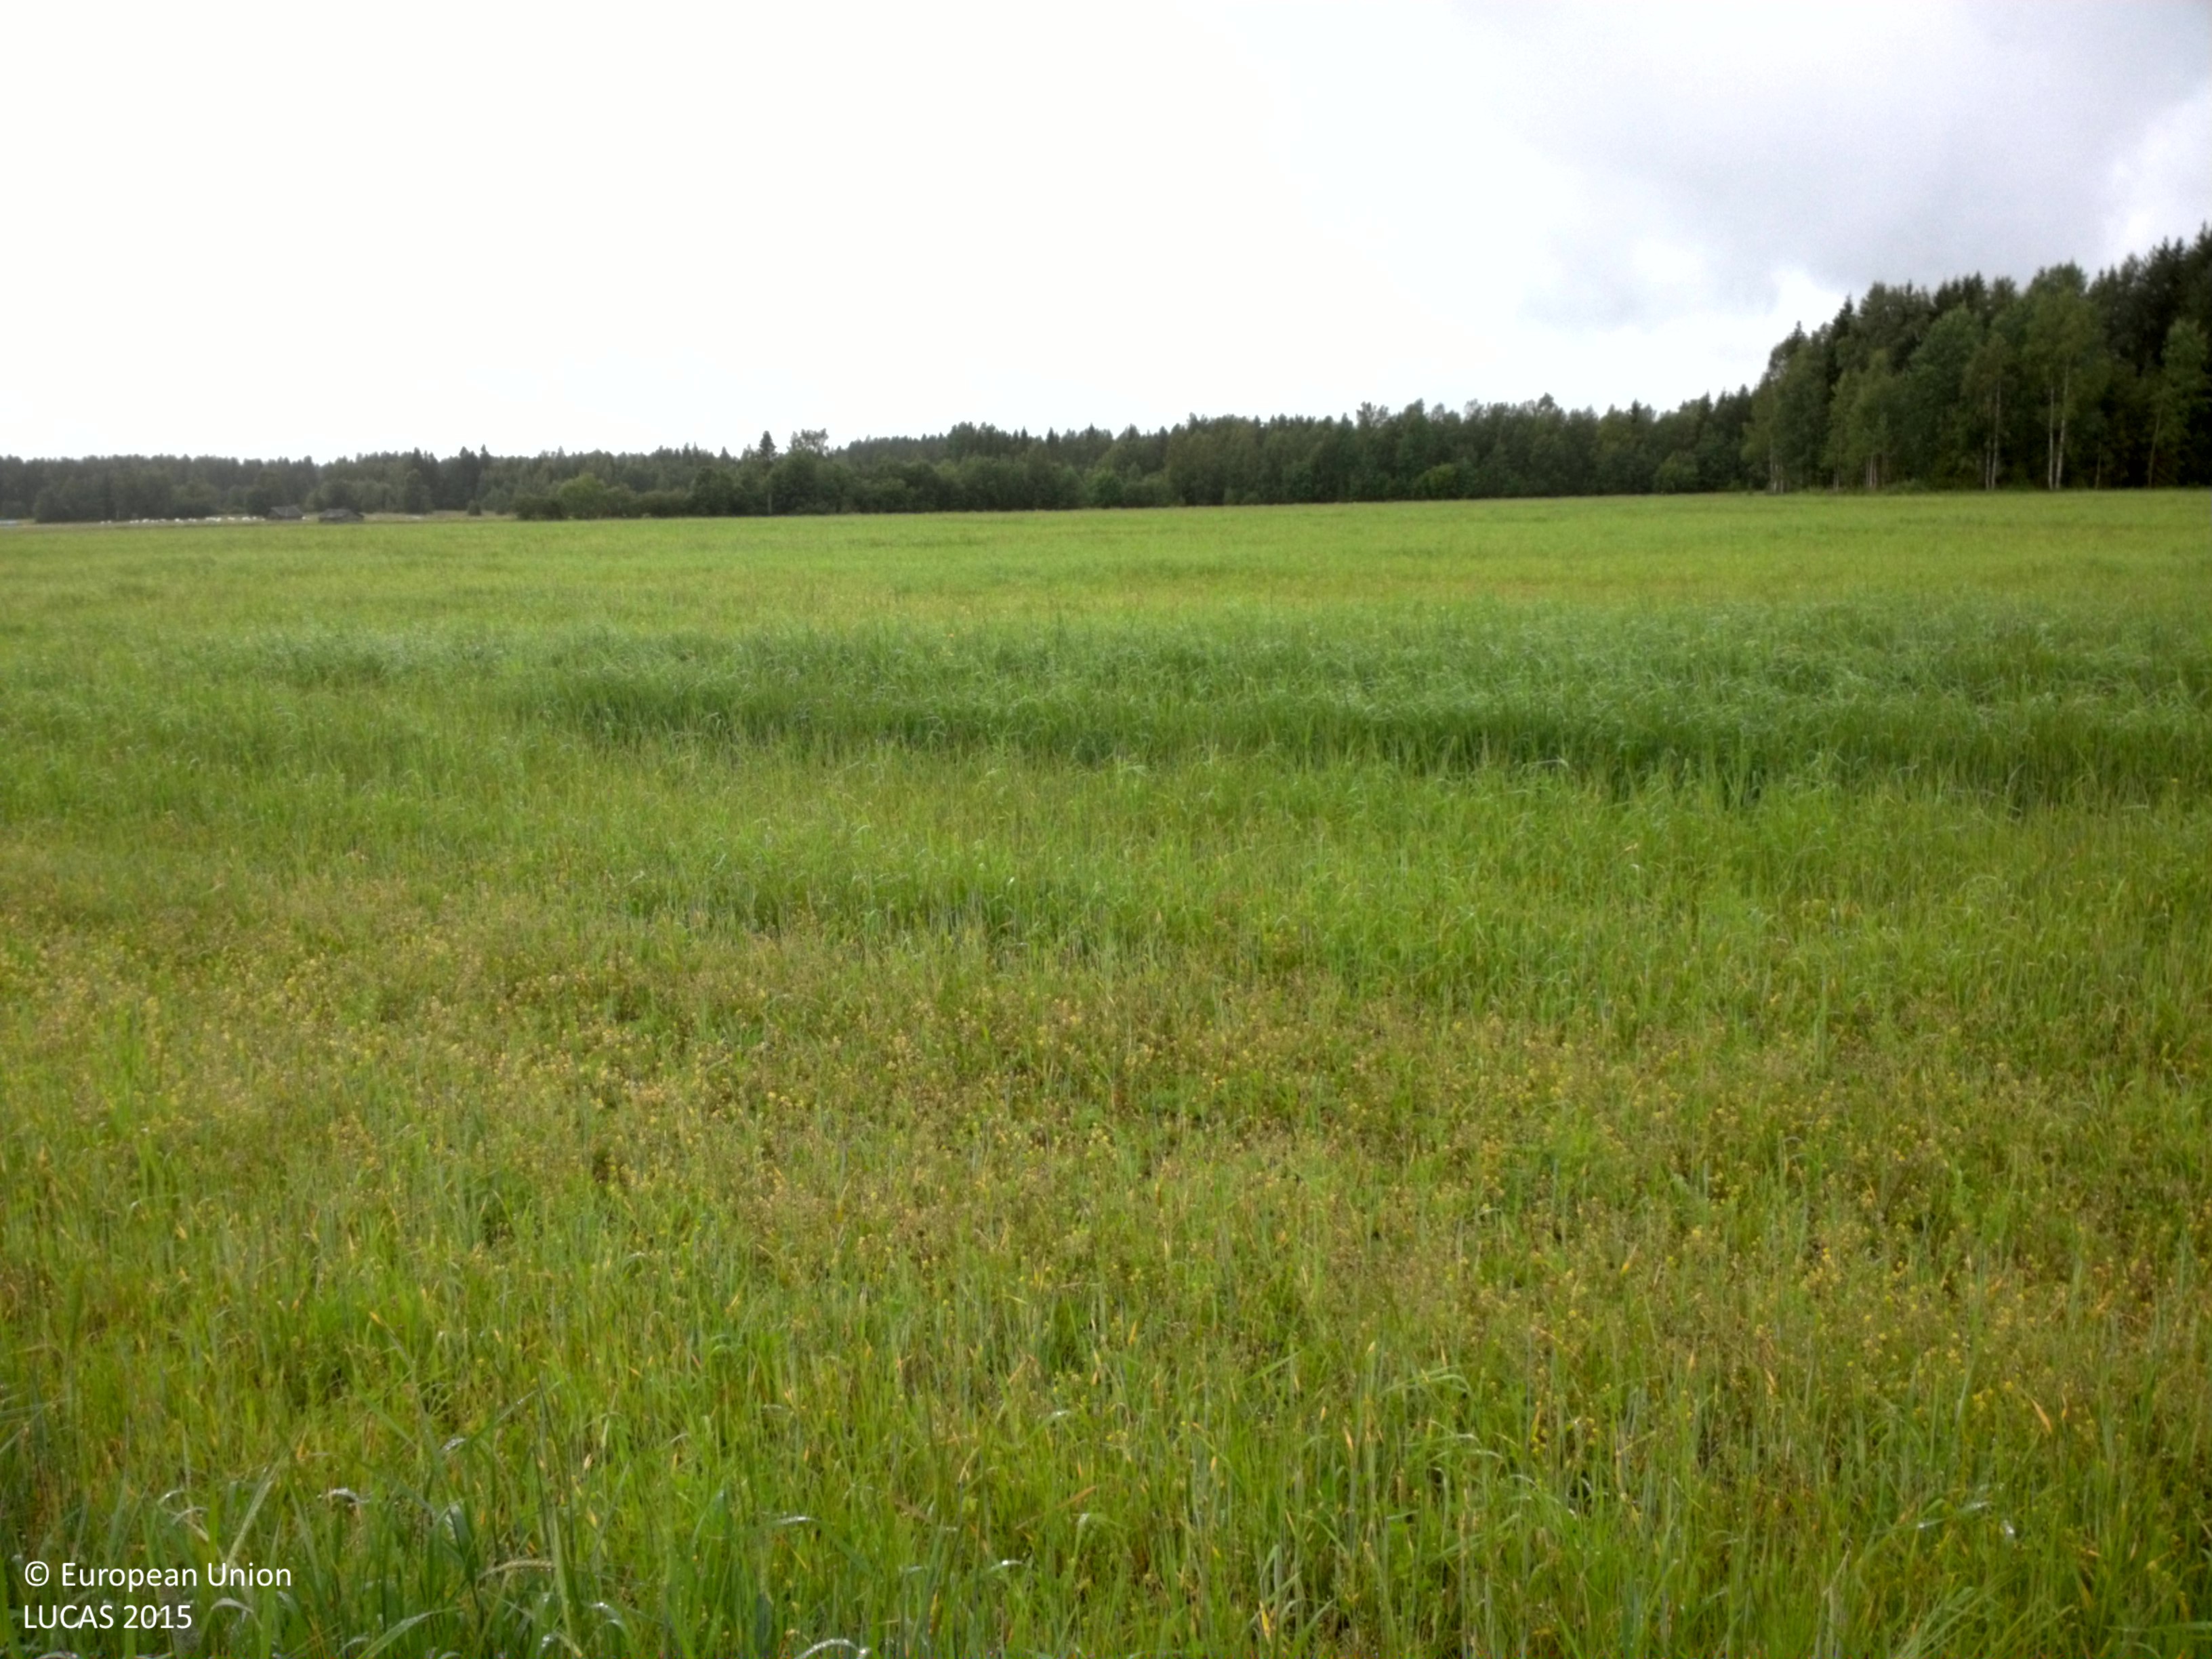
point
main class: Cropland
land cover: Barley
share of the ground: > 75 %
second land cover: Rye
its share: 25 - 50 %
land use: Agriculture (excluding fallow land and kitchen gardens)
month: August
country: SE
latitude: 64.6563
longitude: 20.9716
